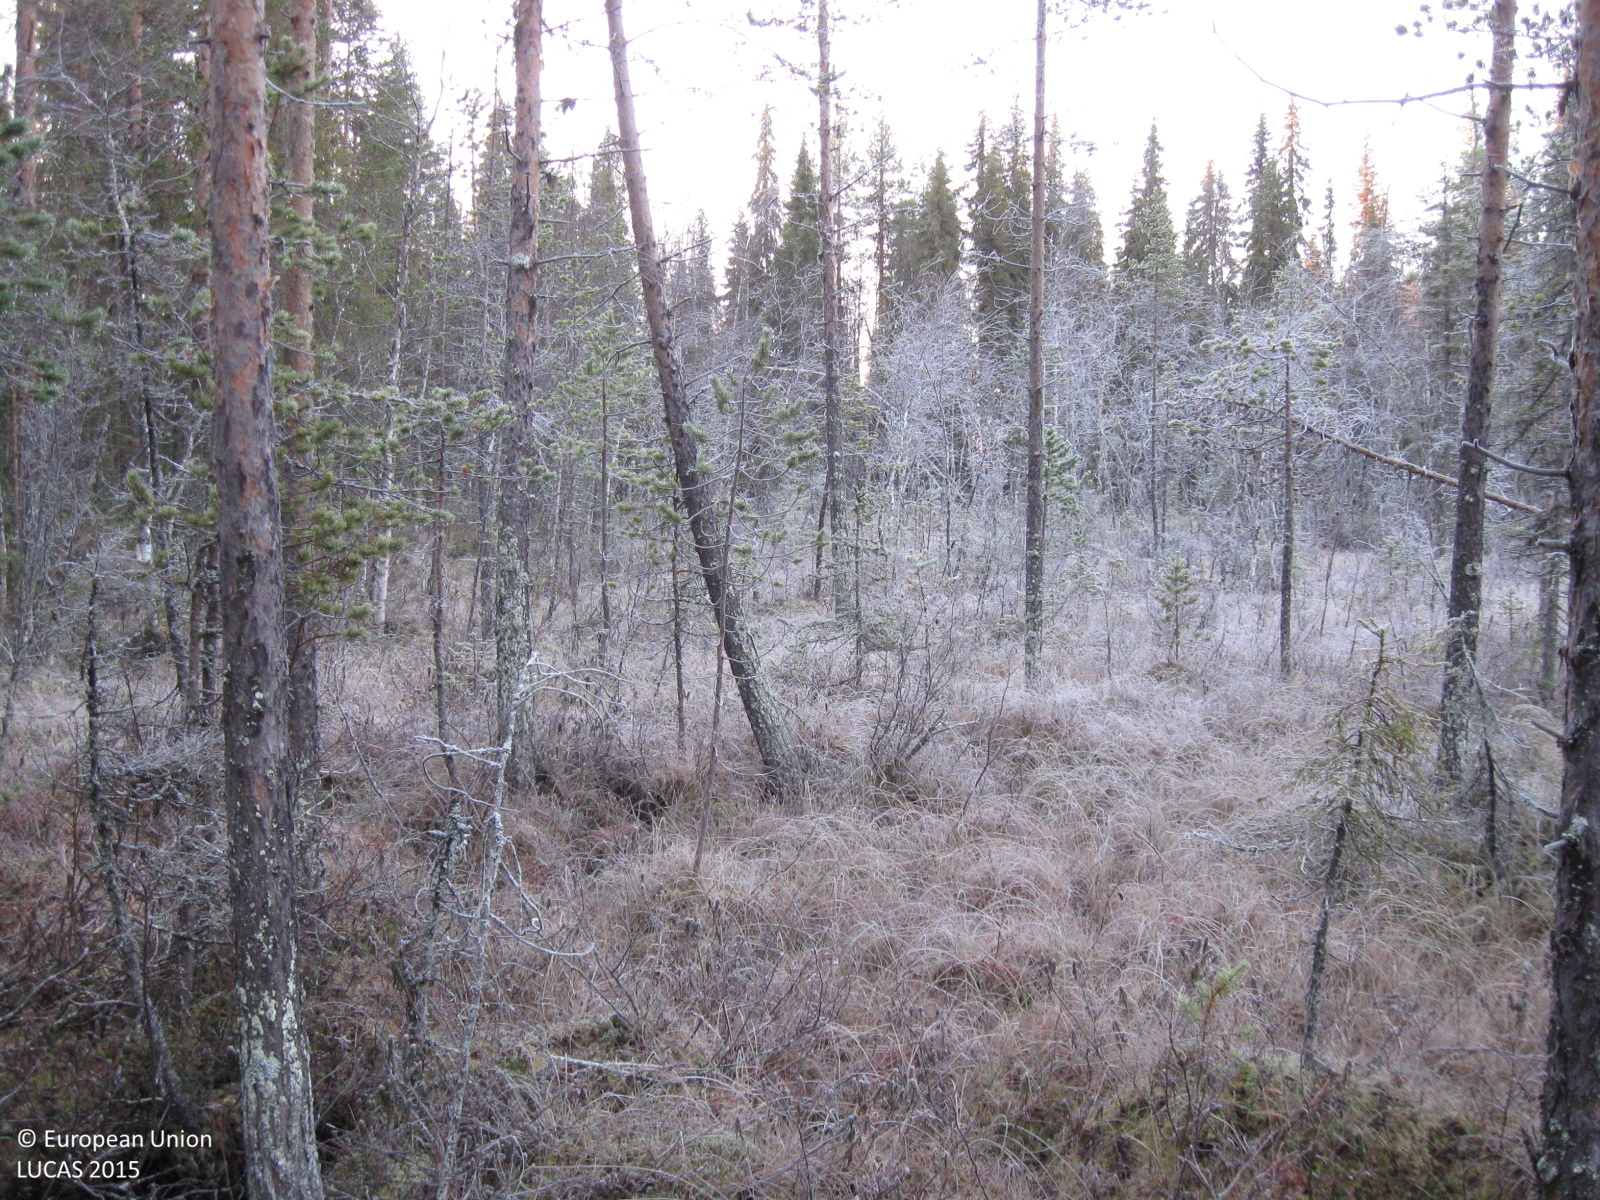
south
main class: Woodland
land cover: Pine dominated coniferous woodland
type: mire and swamp forests
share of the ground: 50 - 75 %
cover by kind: coniferous forest trees 60 %, broadleaved forest trees 10 %, shrubs 10 %, herbaceous plants 10 %, lichens and mosses 10 %
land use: Forestry
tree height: > 5 m
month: October
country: SE
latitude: 66.4697
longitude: 20.9354
